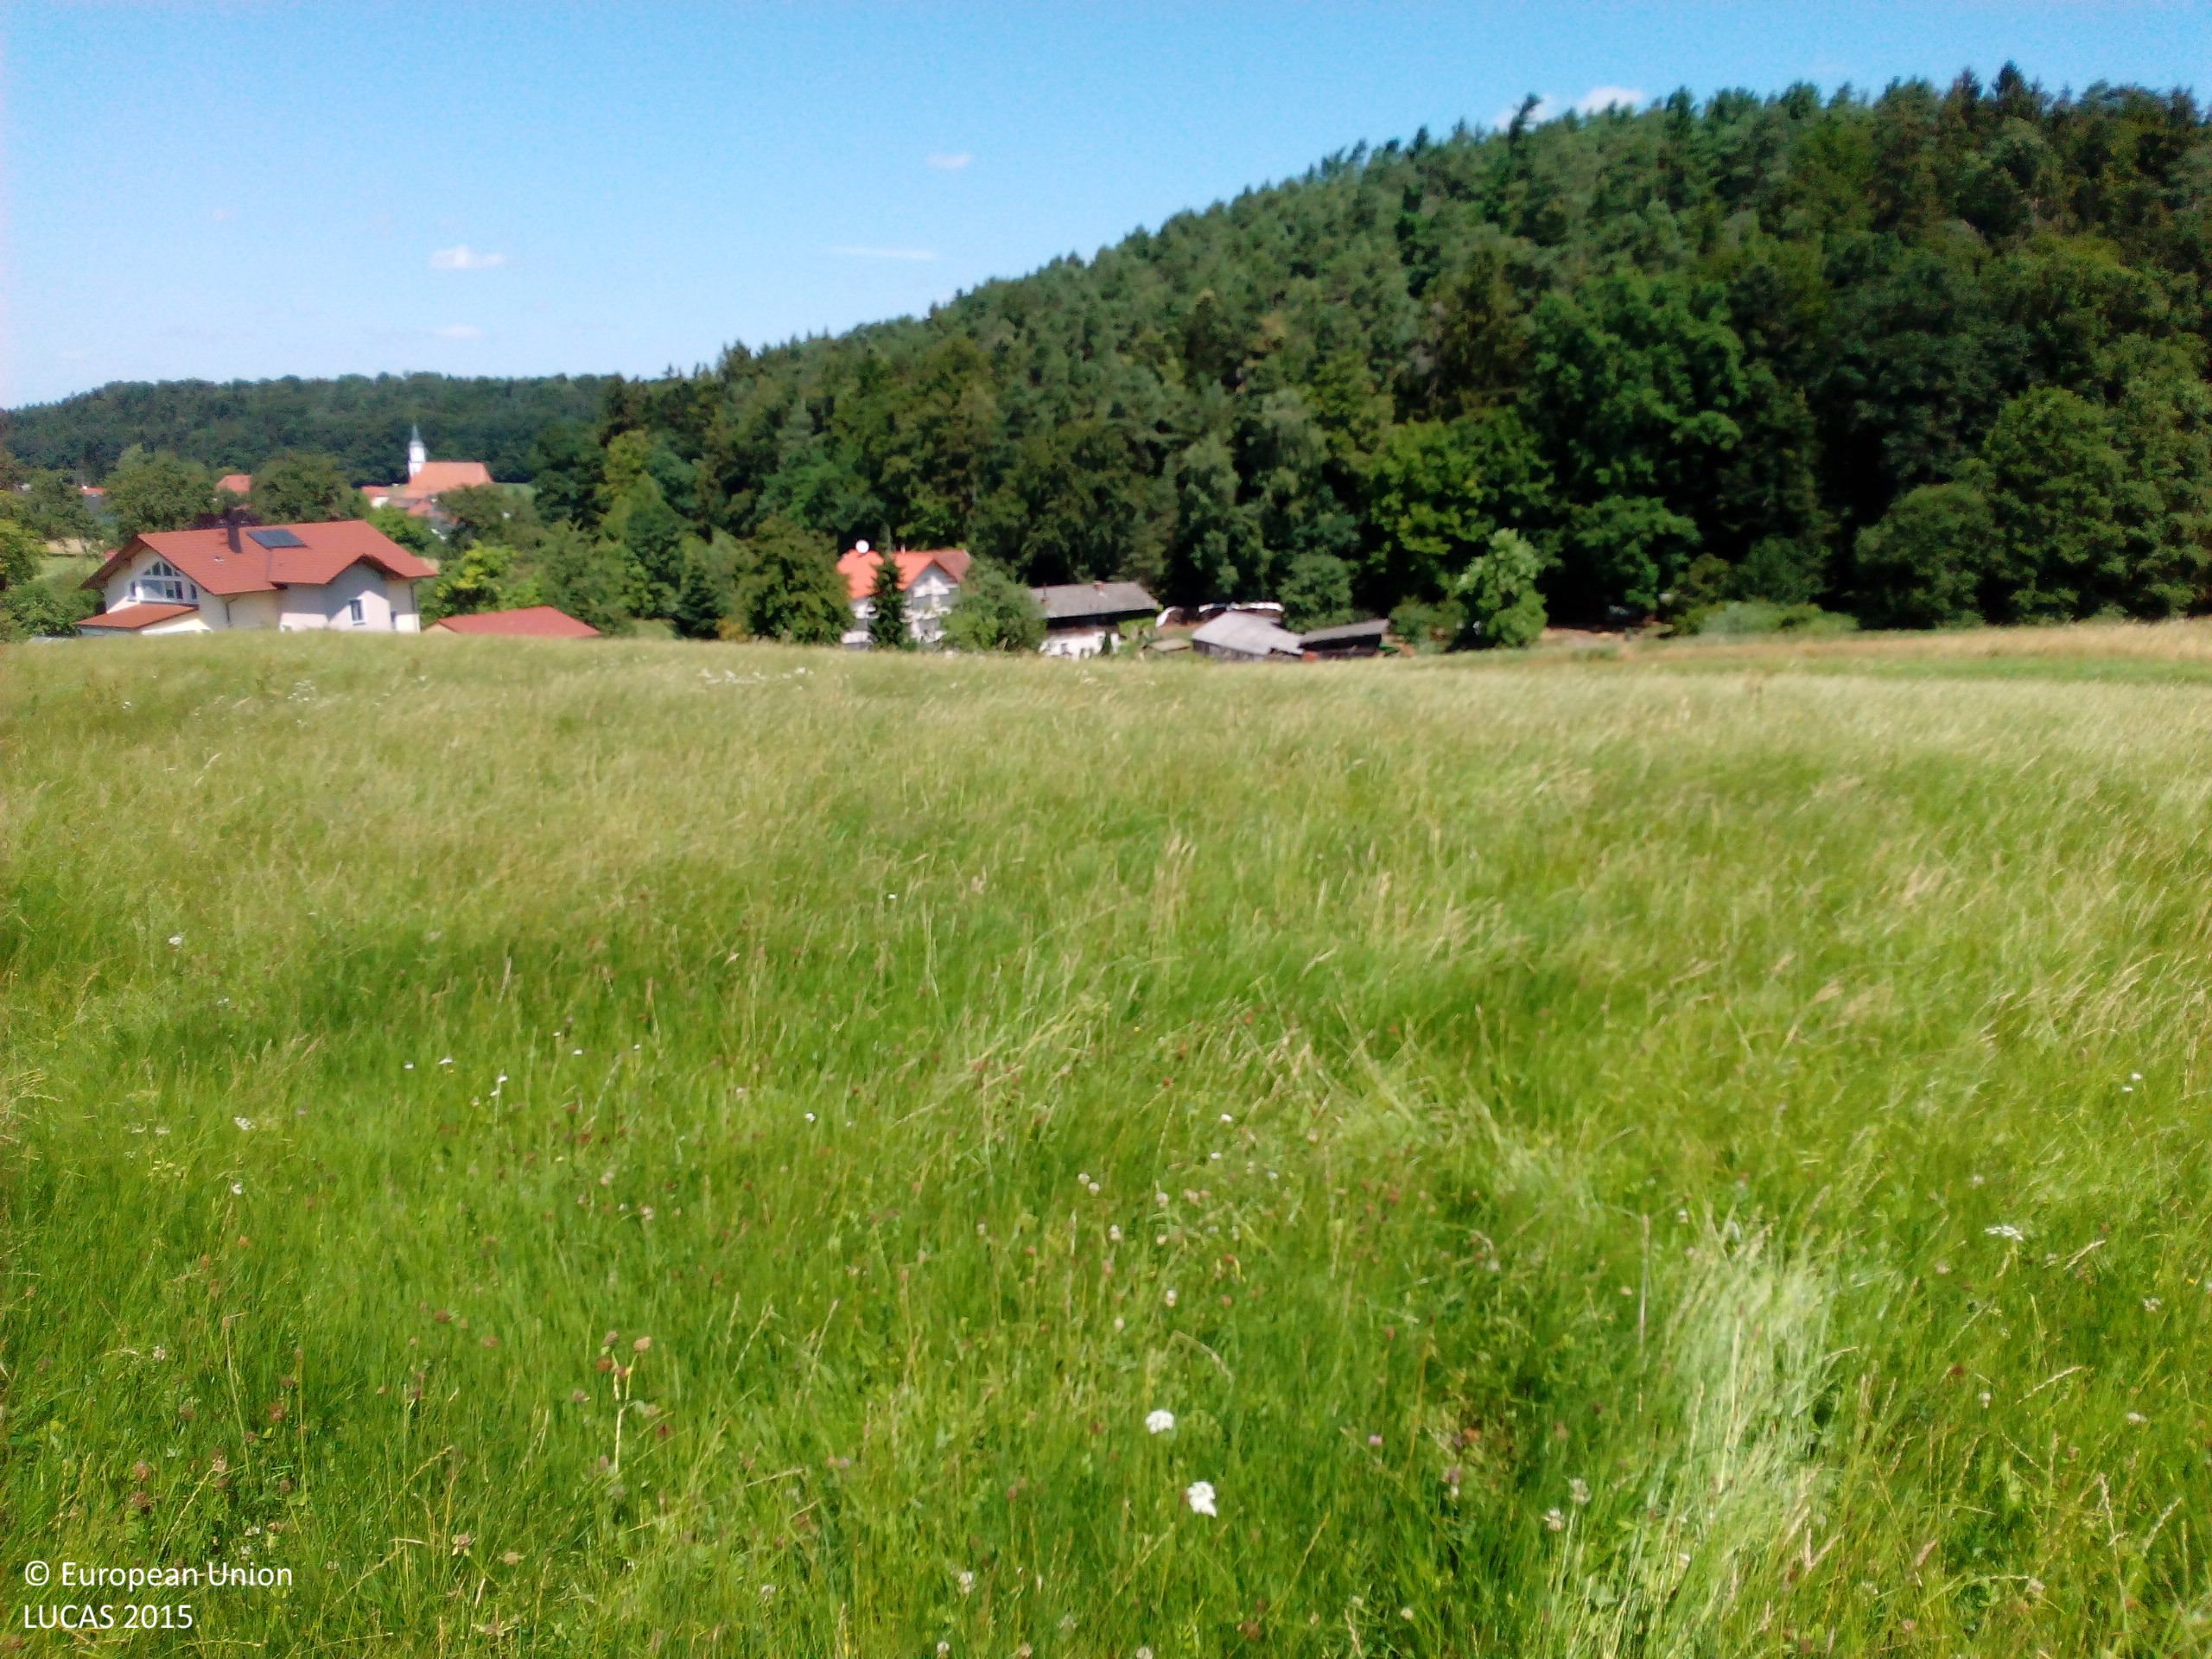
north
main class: Grassland
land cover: Grassland without tree/shrub cover
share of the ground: > 75 %
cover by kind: herbaceous plants 100 %
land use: Agriculture (excluding fallow land and kitchen gardens)
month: July
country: DE
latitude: 48.5722
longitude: 13.2386
